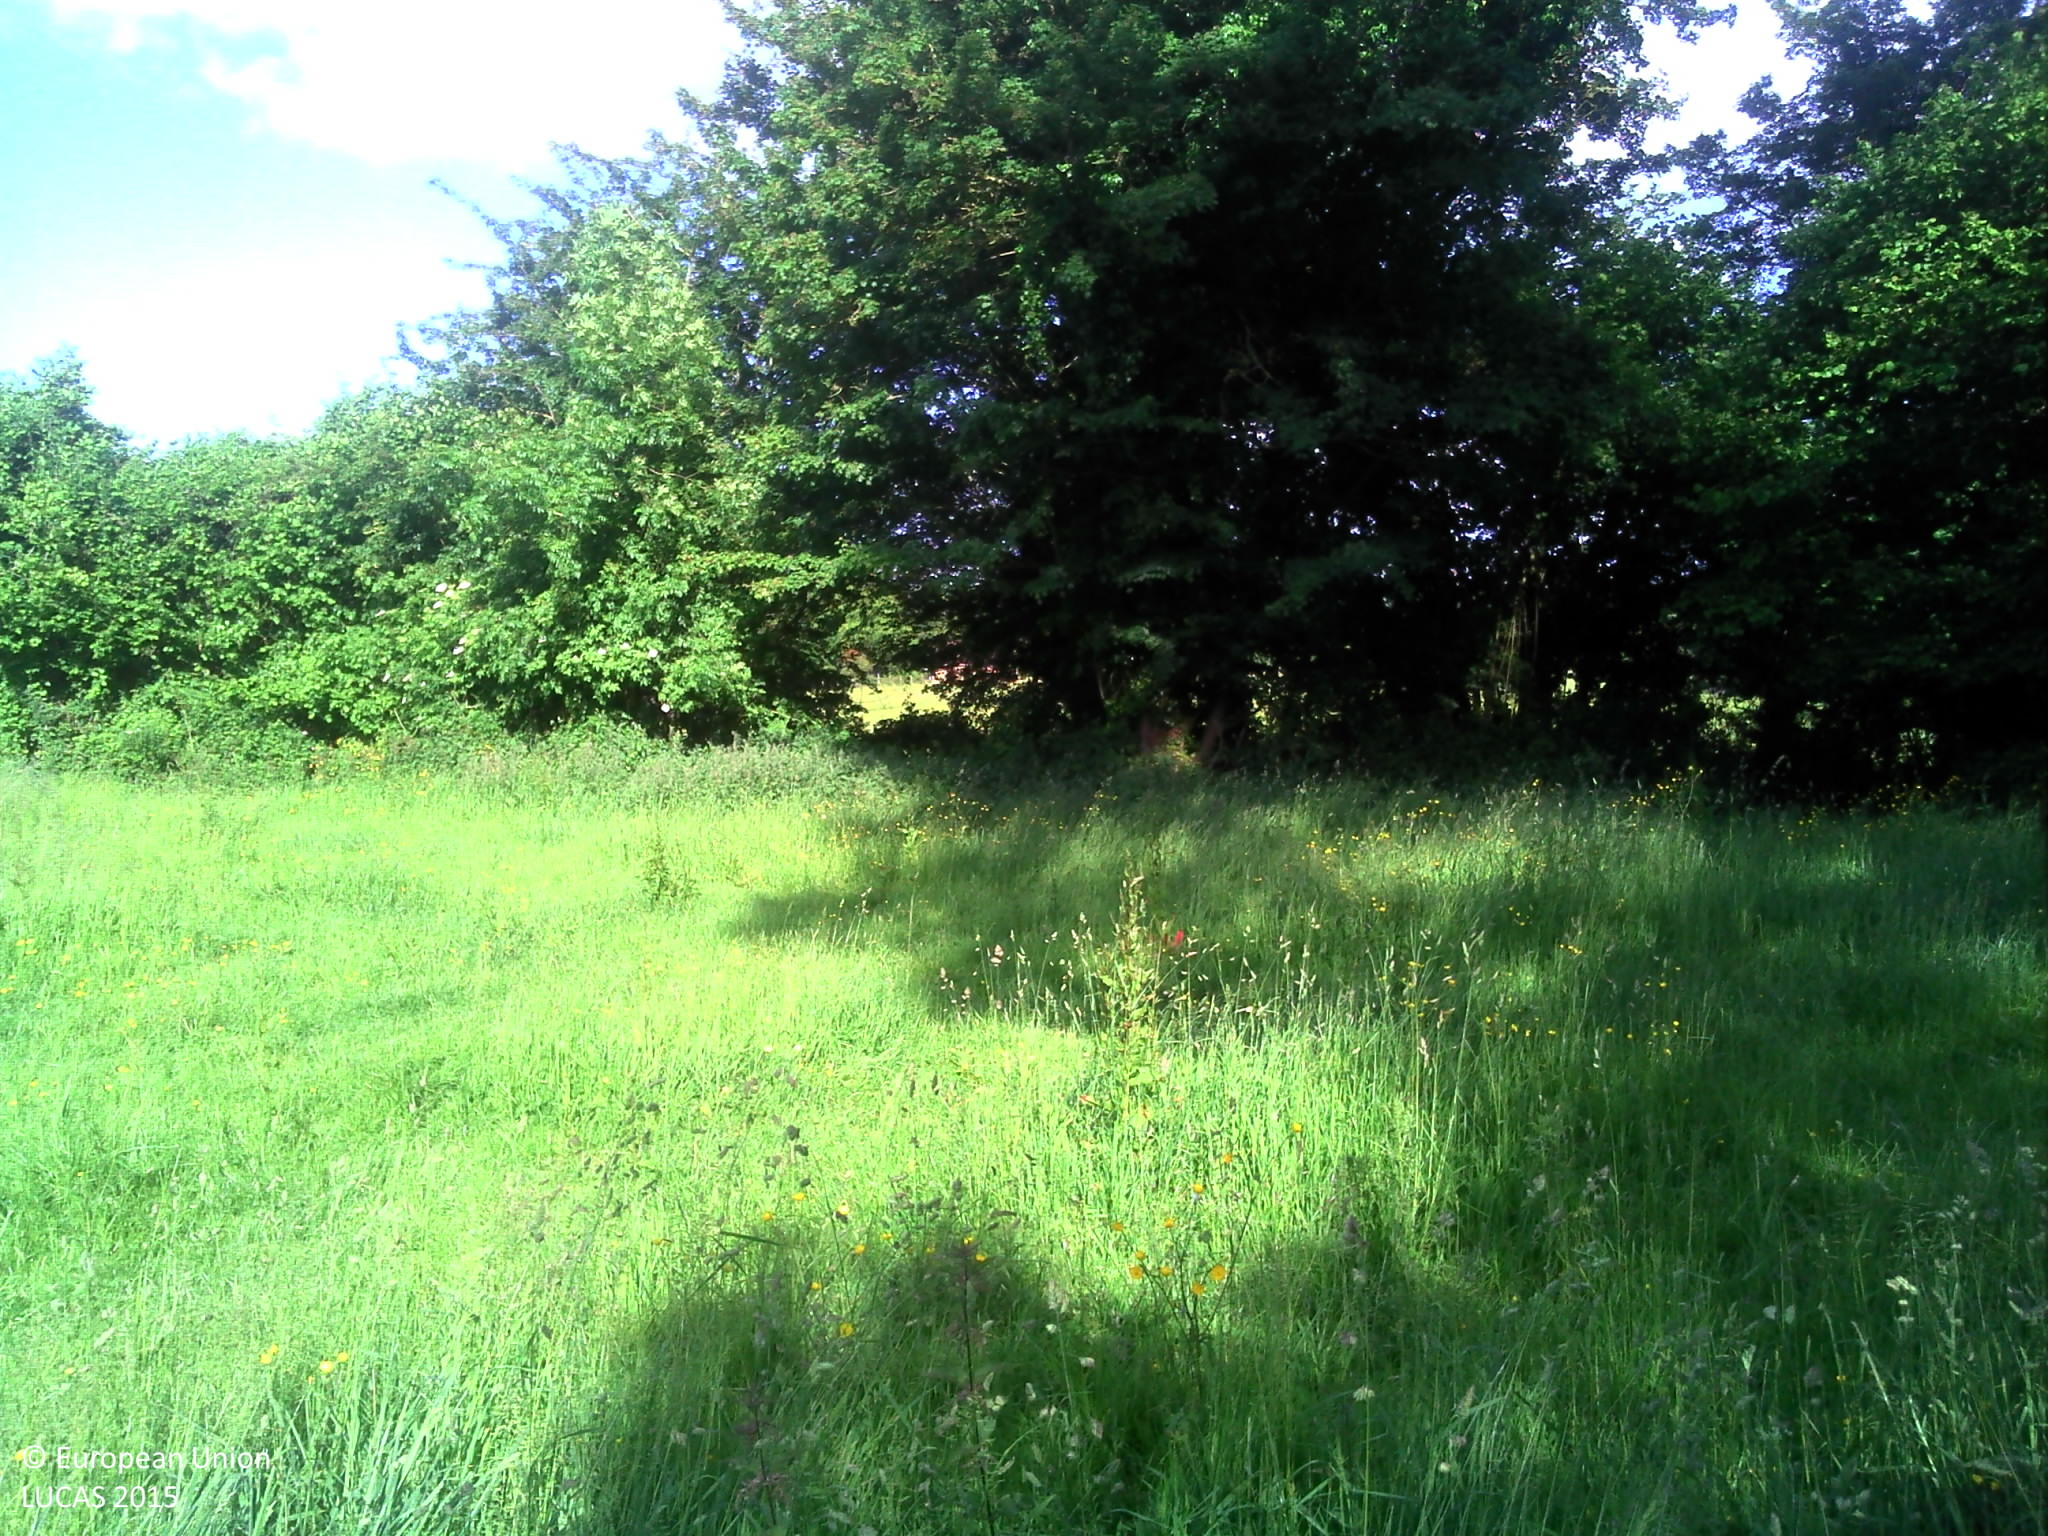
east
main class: Grassland
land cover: Grassland without tree/shrub cover
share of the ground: > 75 %
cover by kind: herbaceous plants 100 %
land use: Agriculture (excluding fallow land and kitchen gardens)
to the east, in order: Grassland without tree/shrub cover; Fences; Abandoned hedges; Ditches and canals; Abandoned hedges; Fences; Grassland without tree/shrub cover; Single bushes/trees; Grassland without tree/shrub cover; Artificial constructions in urban areas; Grassland without tree/shrub cover
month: June
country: FR
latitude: 48.8301
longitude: 0.1218
